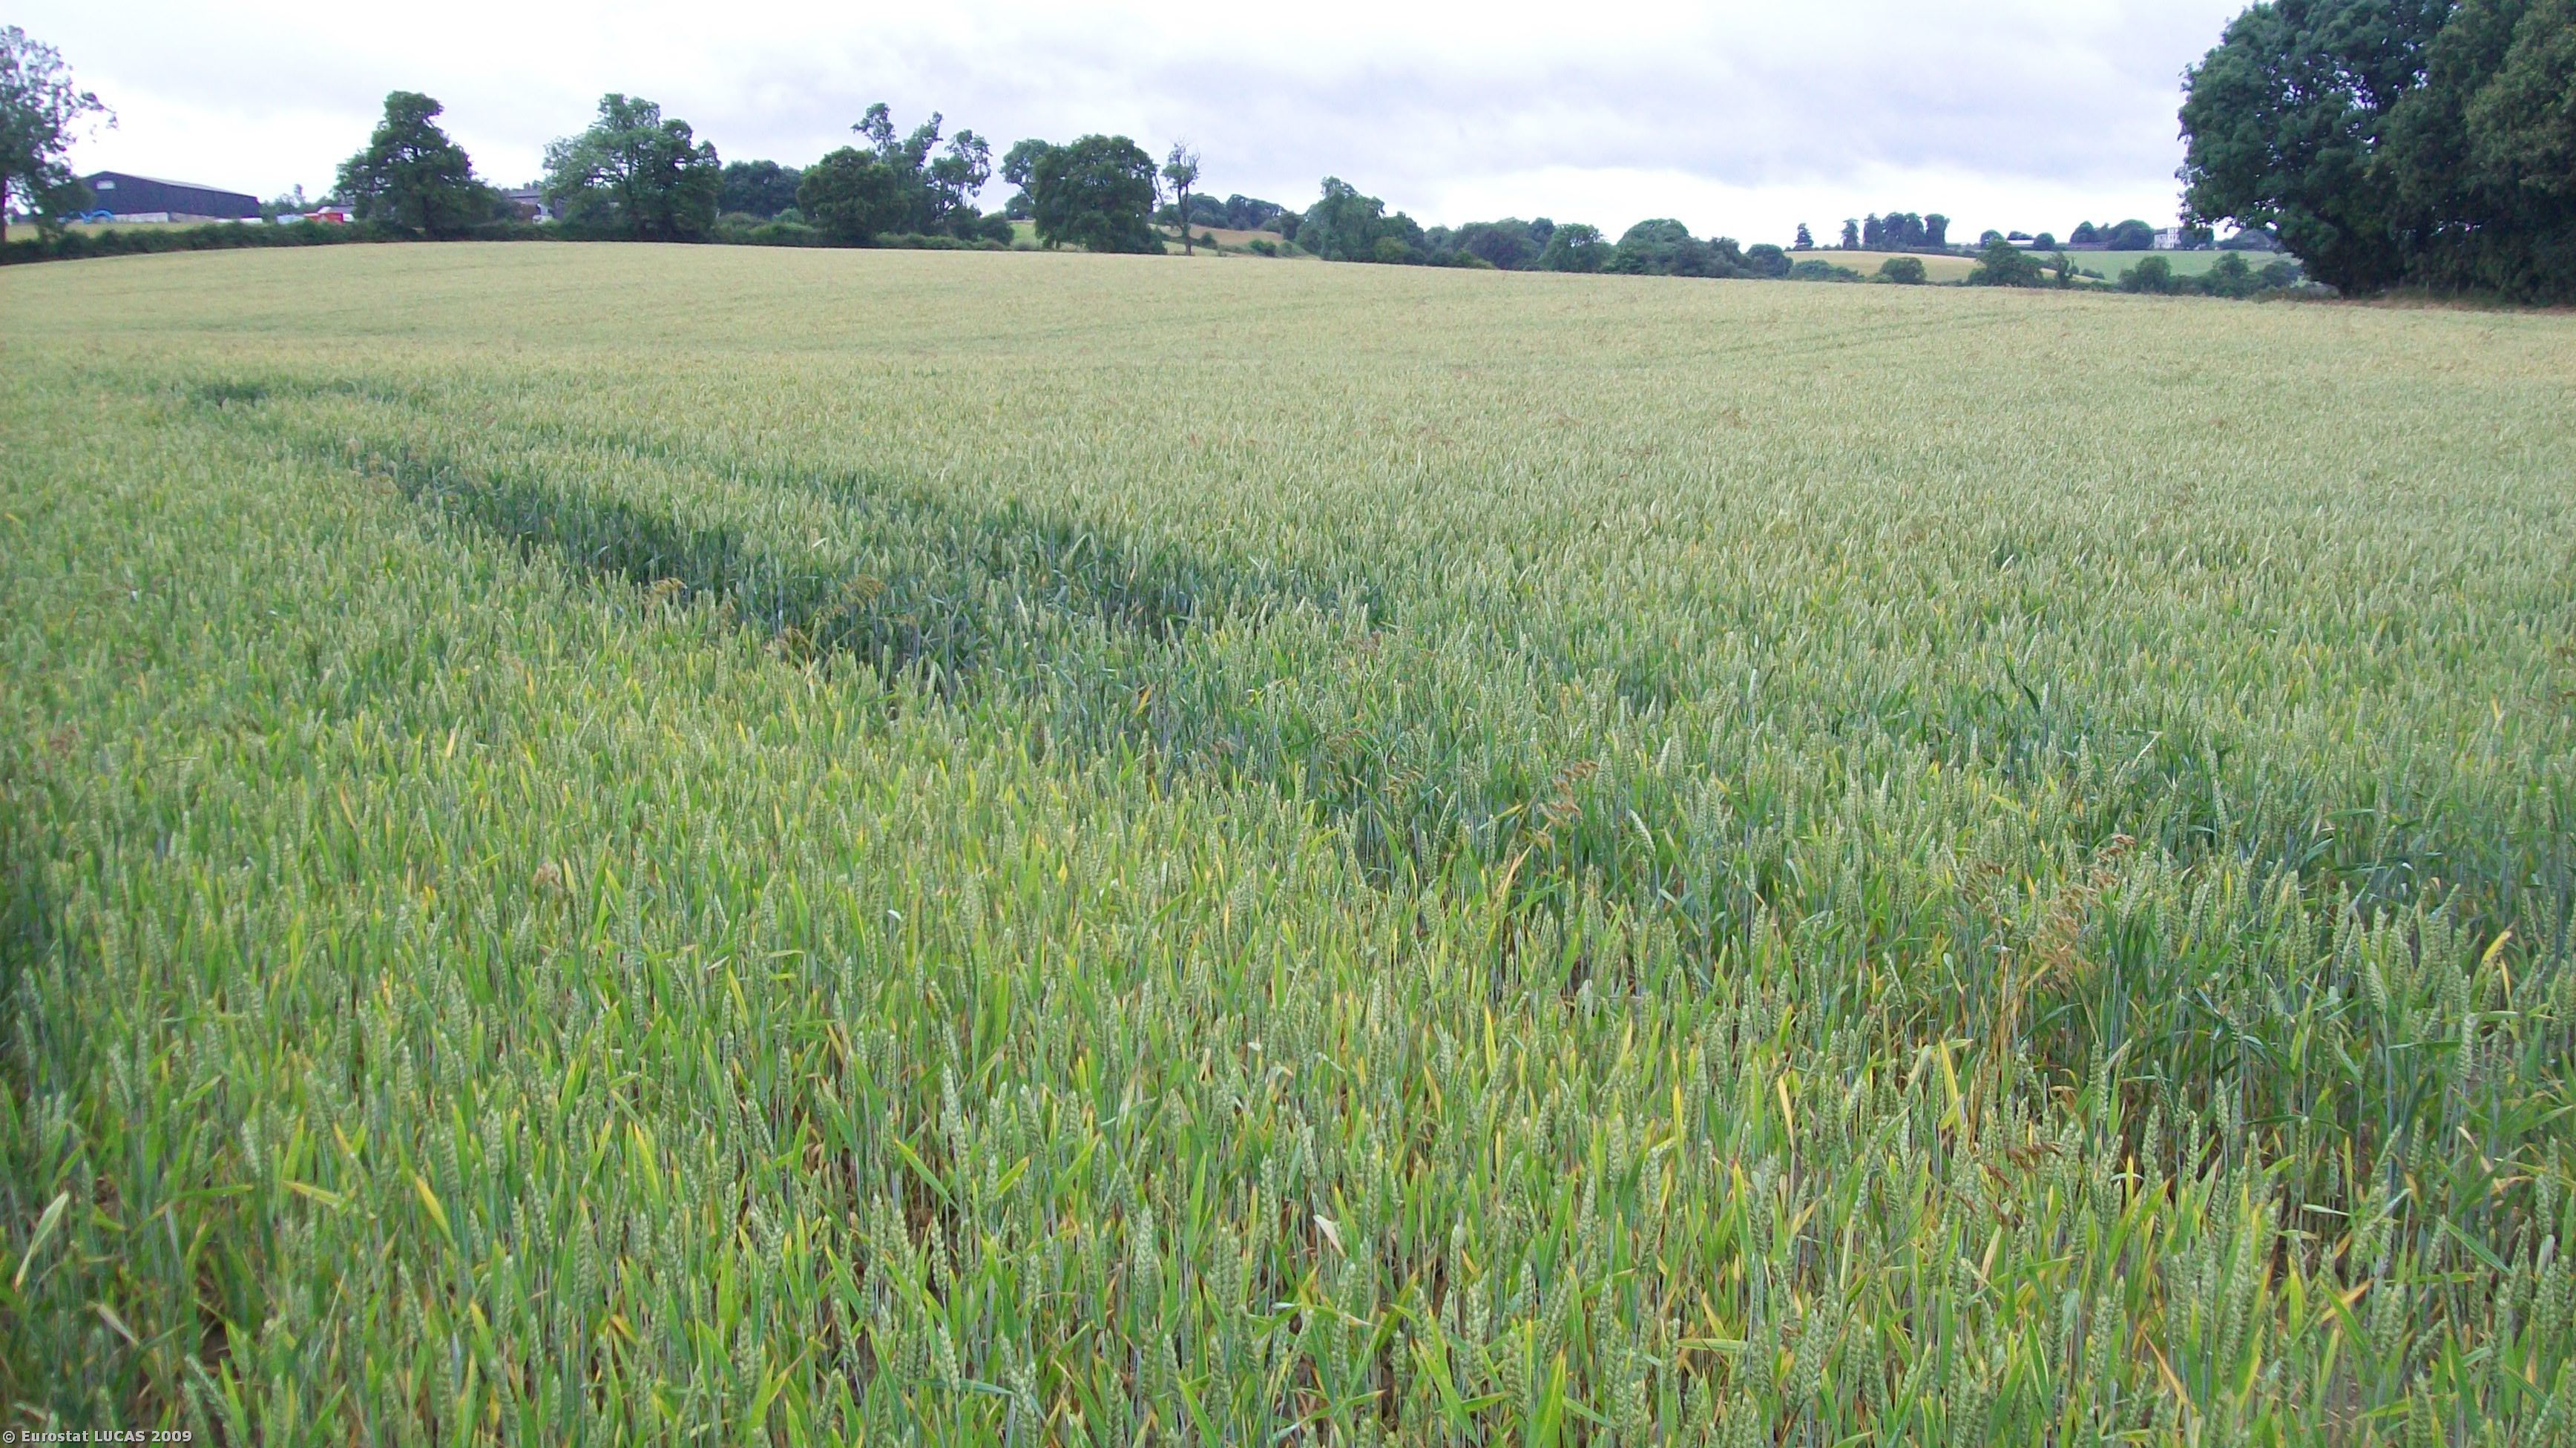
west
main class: Cropland
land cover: Common wheat
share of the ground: > 75 %
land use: Agriculture (excluding fallow land and kitchen gardens)
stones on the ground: 10 - 25 %
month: July
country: GB
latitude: 52.7662
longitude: -1.4470
